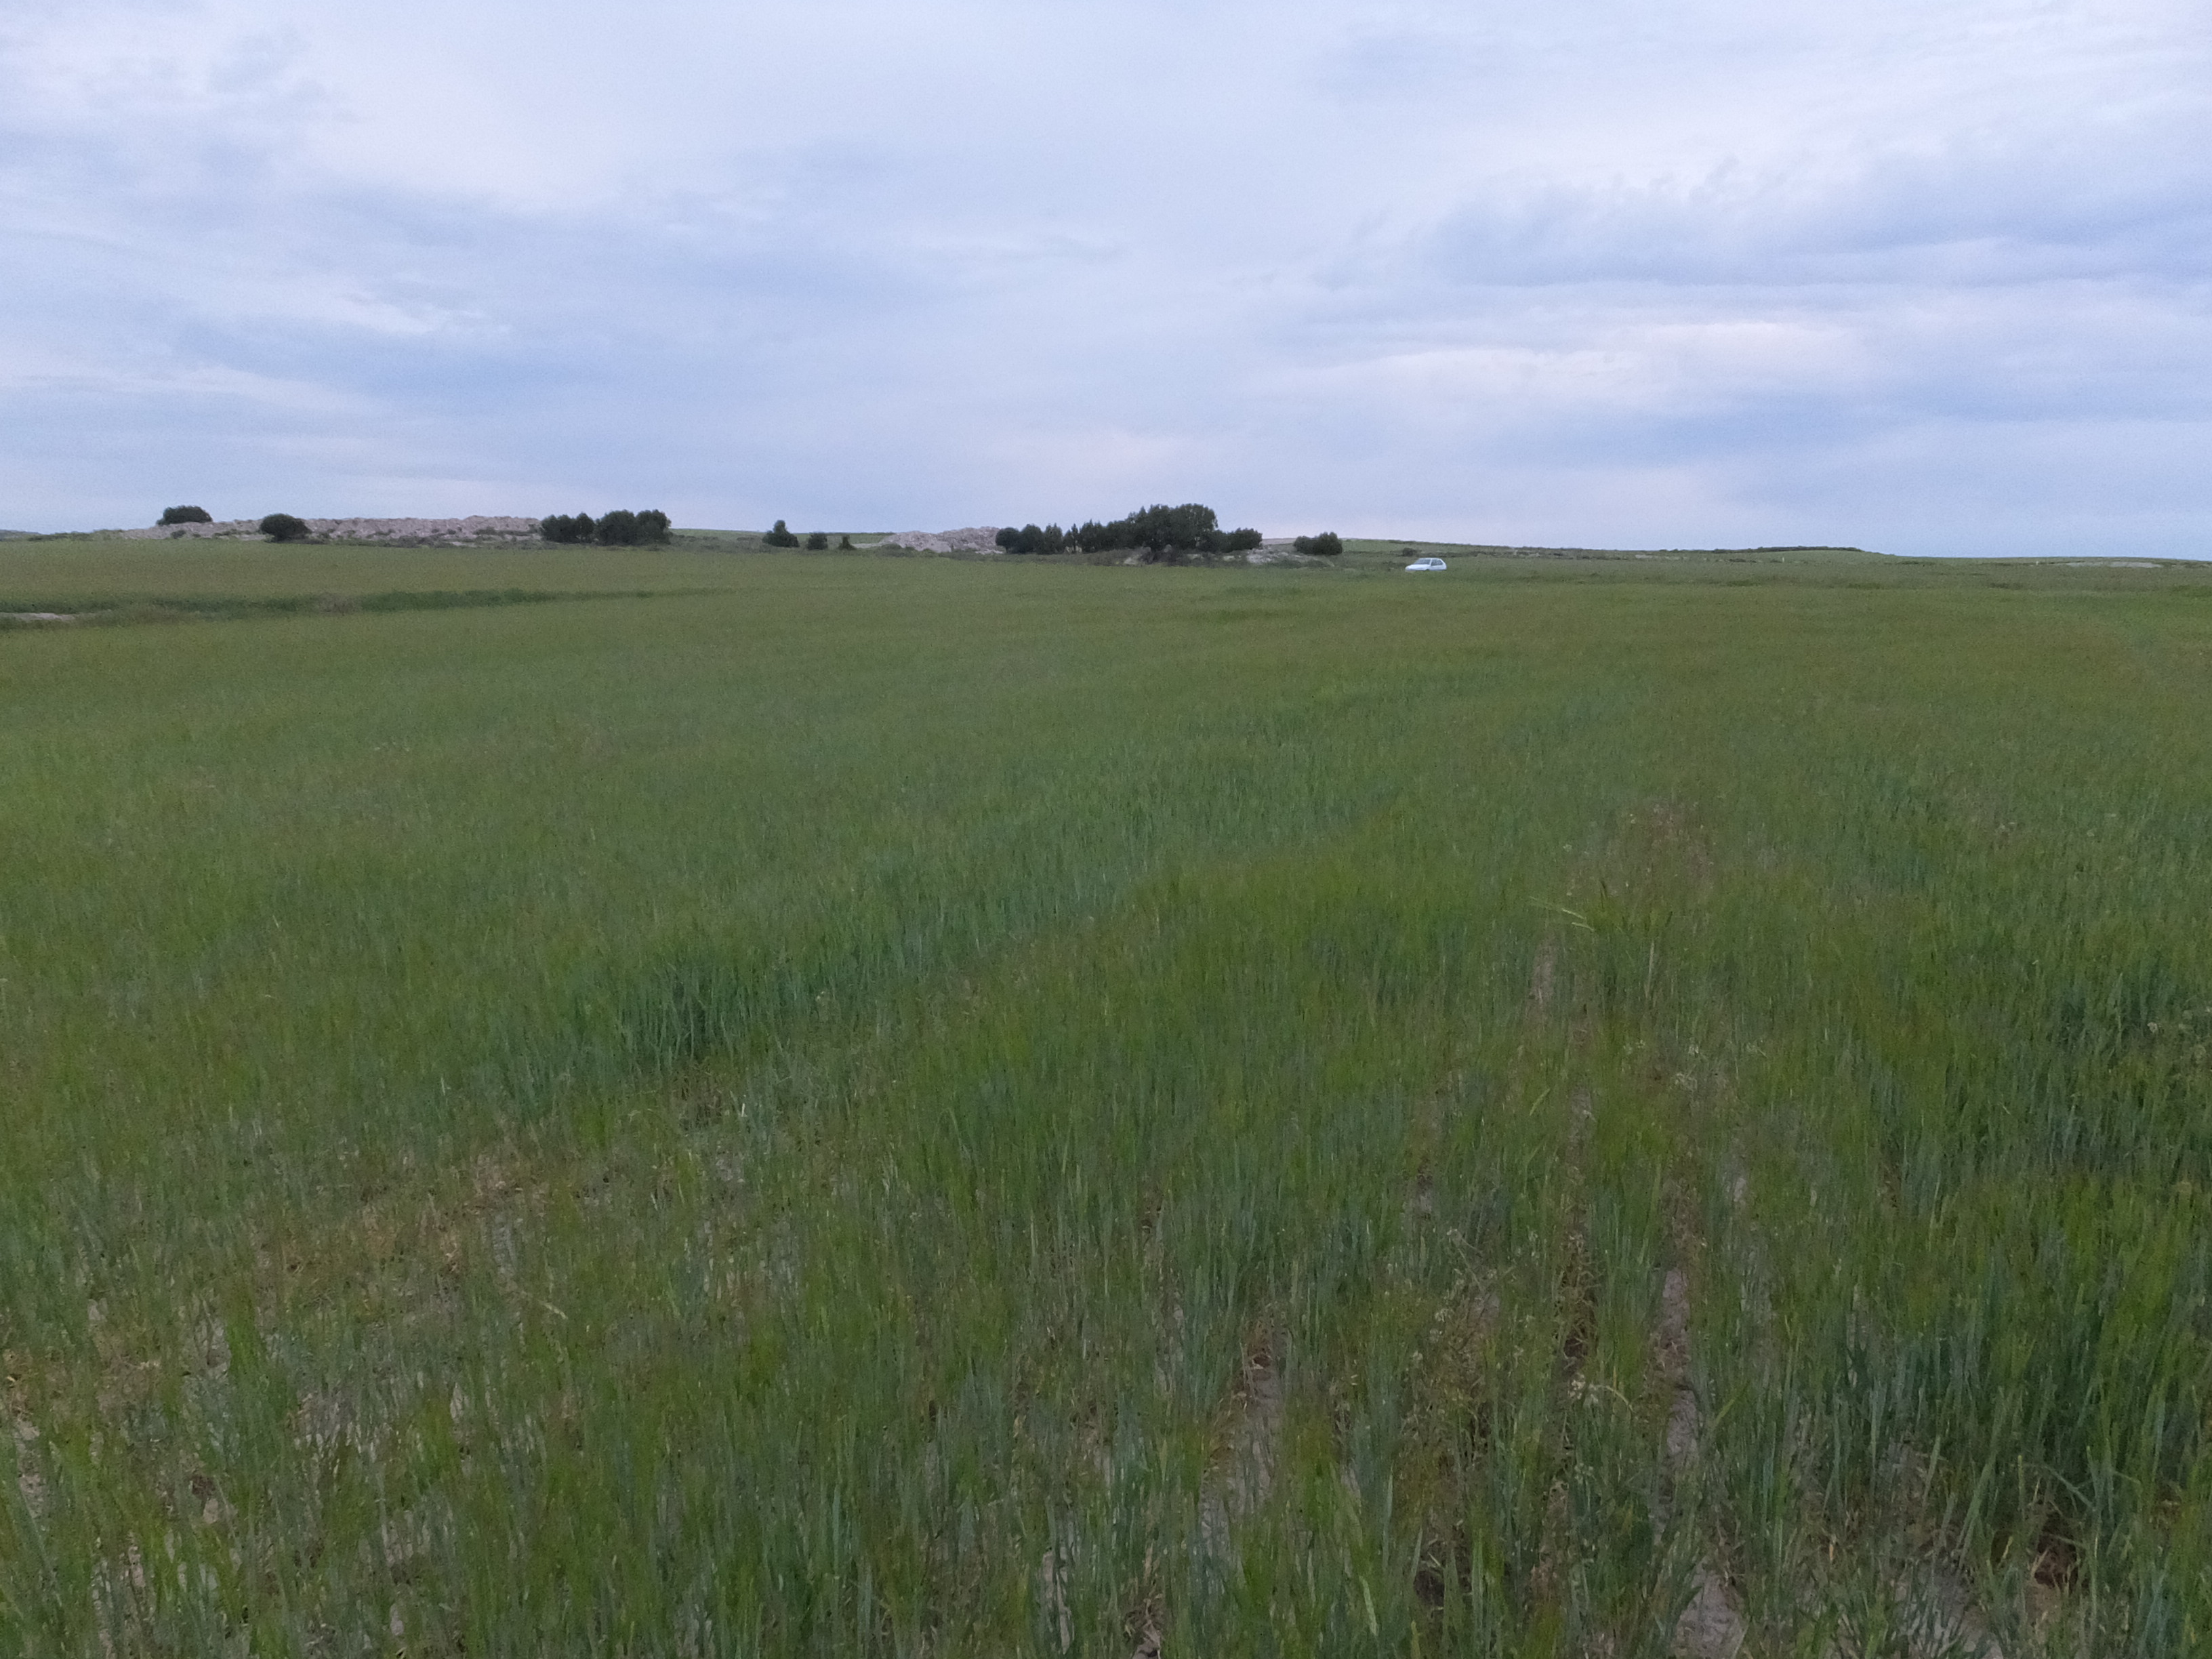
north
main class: Cropland
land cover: Barley
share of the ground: > 75 %
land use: Agriculture (excluding fallow land and kitchen gardens)
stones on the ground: < 10 %
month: April
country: ES
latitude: 41.6324
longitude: -0.1600
